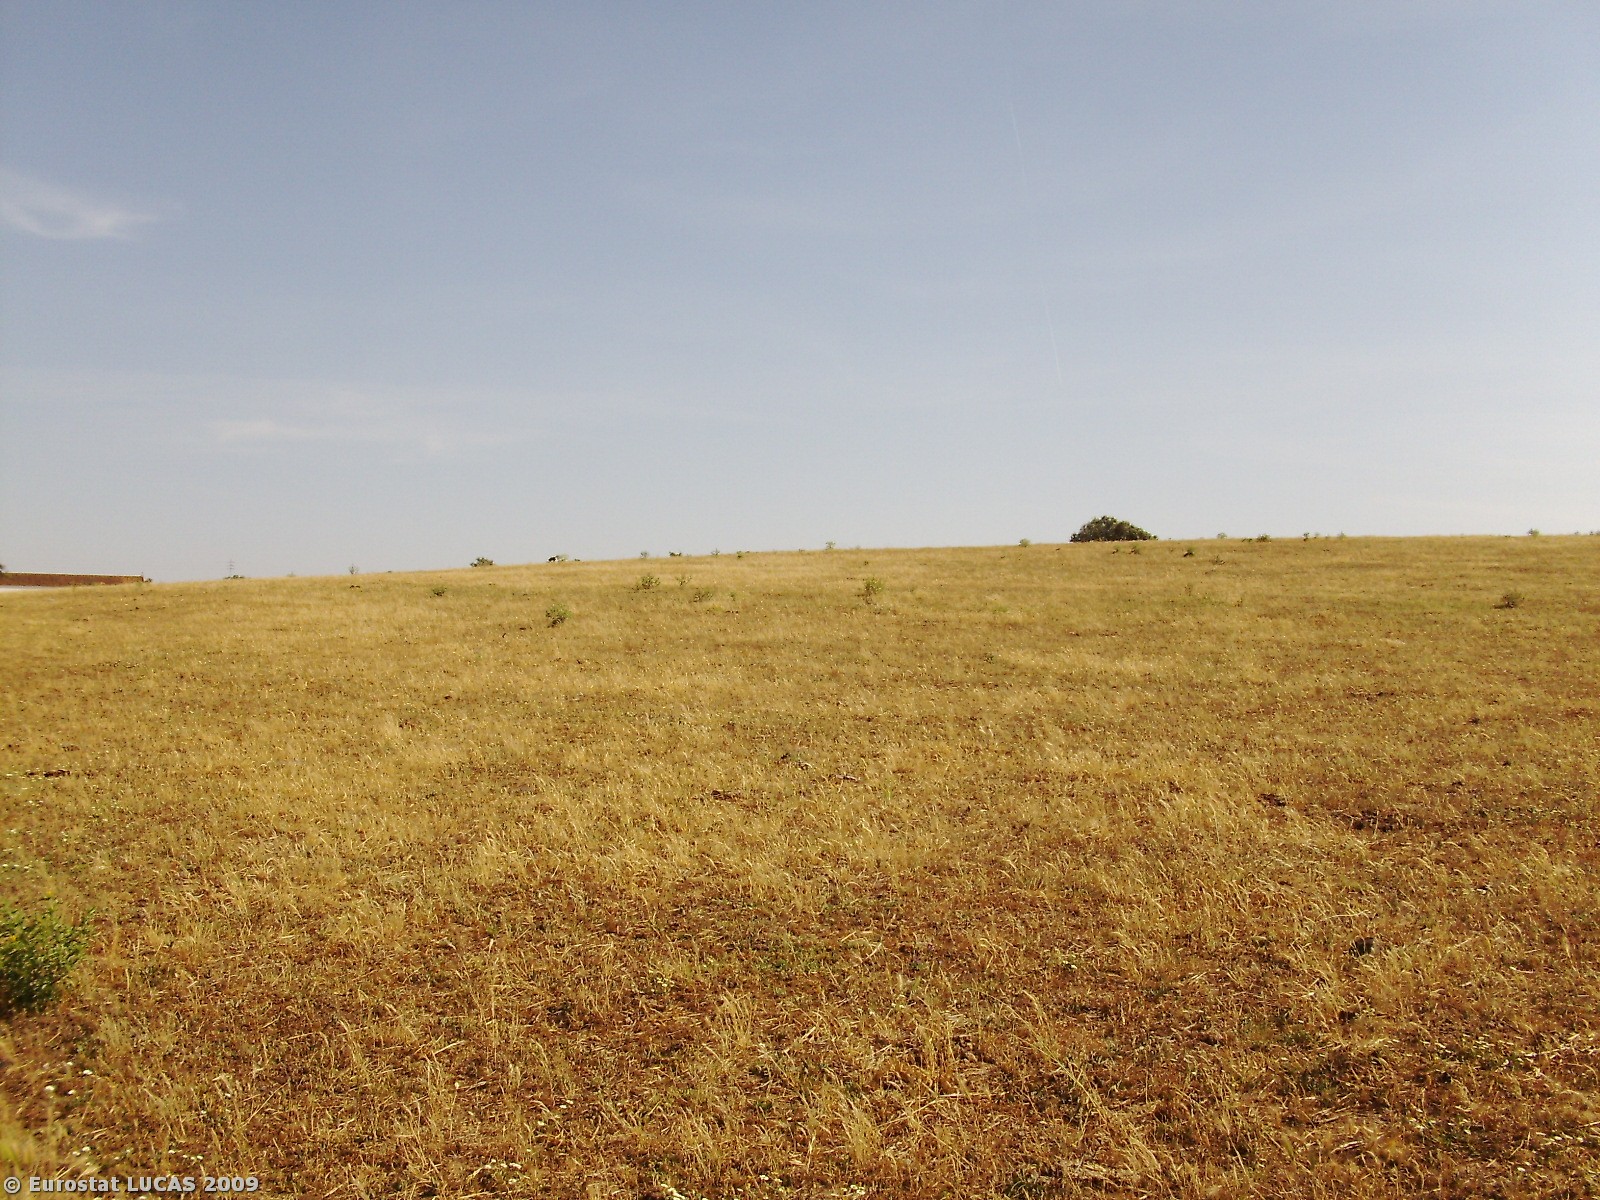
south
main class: Grassland
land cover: Grassland without tree/shrub cover
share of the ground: > 75 %
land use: Agriculture (excluding fallow land and kitchen gardens)
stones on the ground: 10 - 25 %
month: June
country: PT
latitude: 39.0667
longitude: -7.4079
